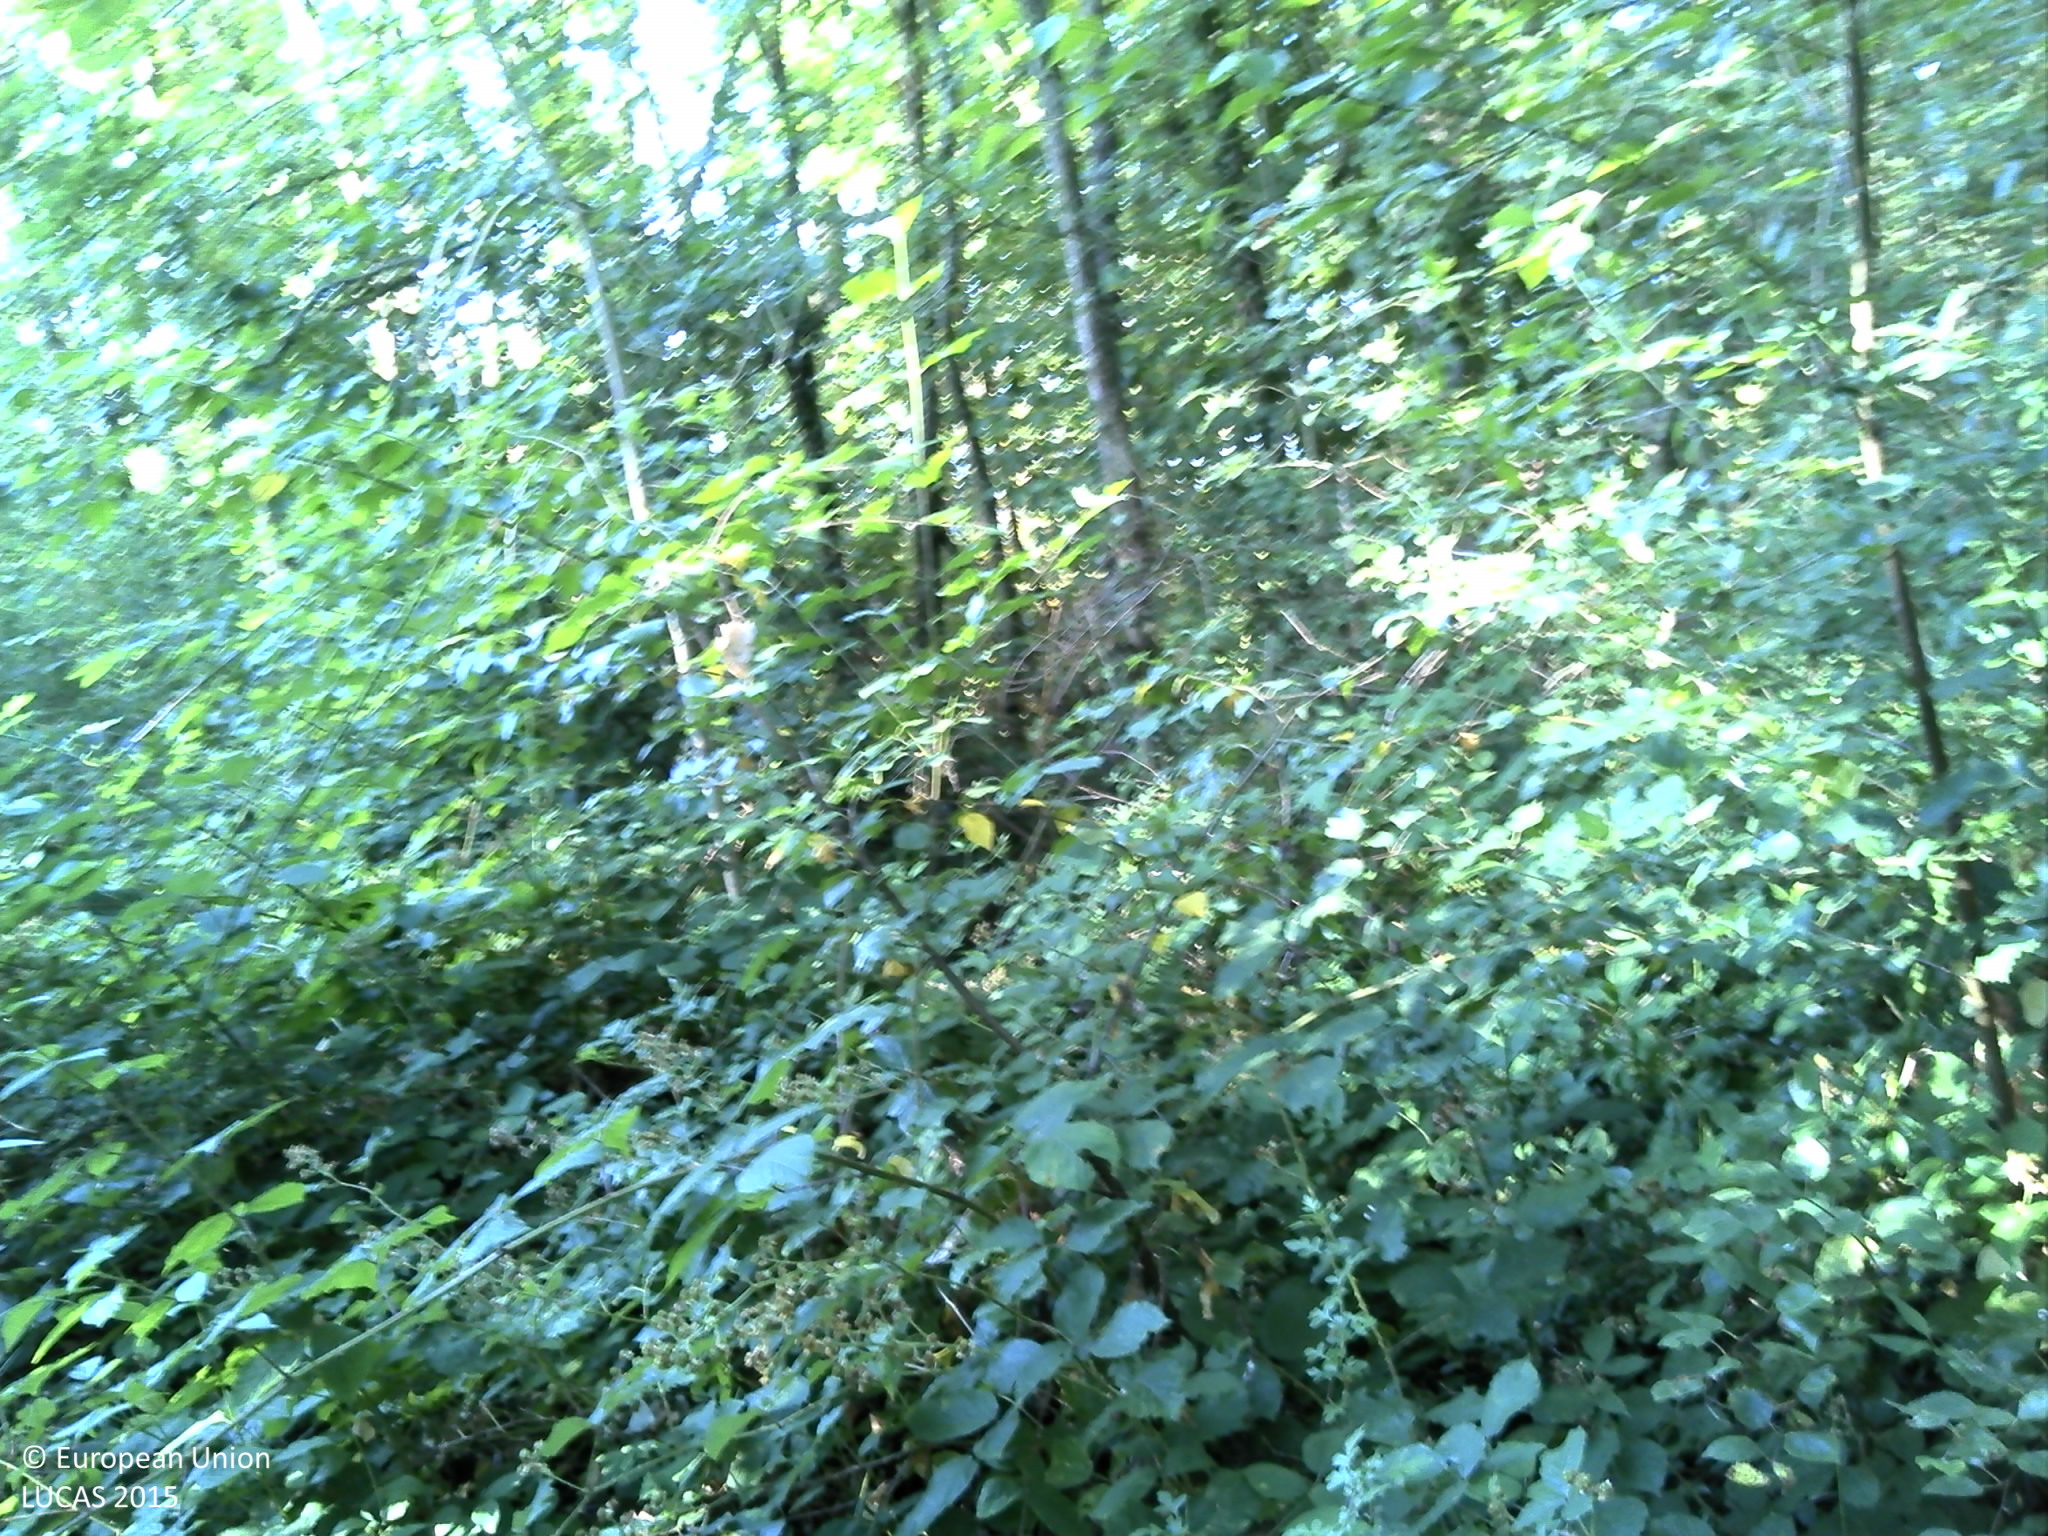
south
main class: Woodland
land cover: Broadleaved woodland
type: mesophytic deciduous forest
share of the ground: > 75 %
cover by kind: broadleaved forest trees 85 %, herbaceous plants 15 %
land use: Forestry
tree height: > 5 m
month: July
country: FR
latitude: 48.2639
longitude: 6.1341
